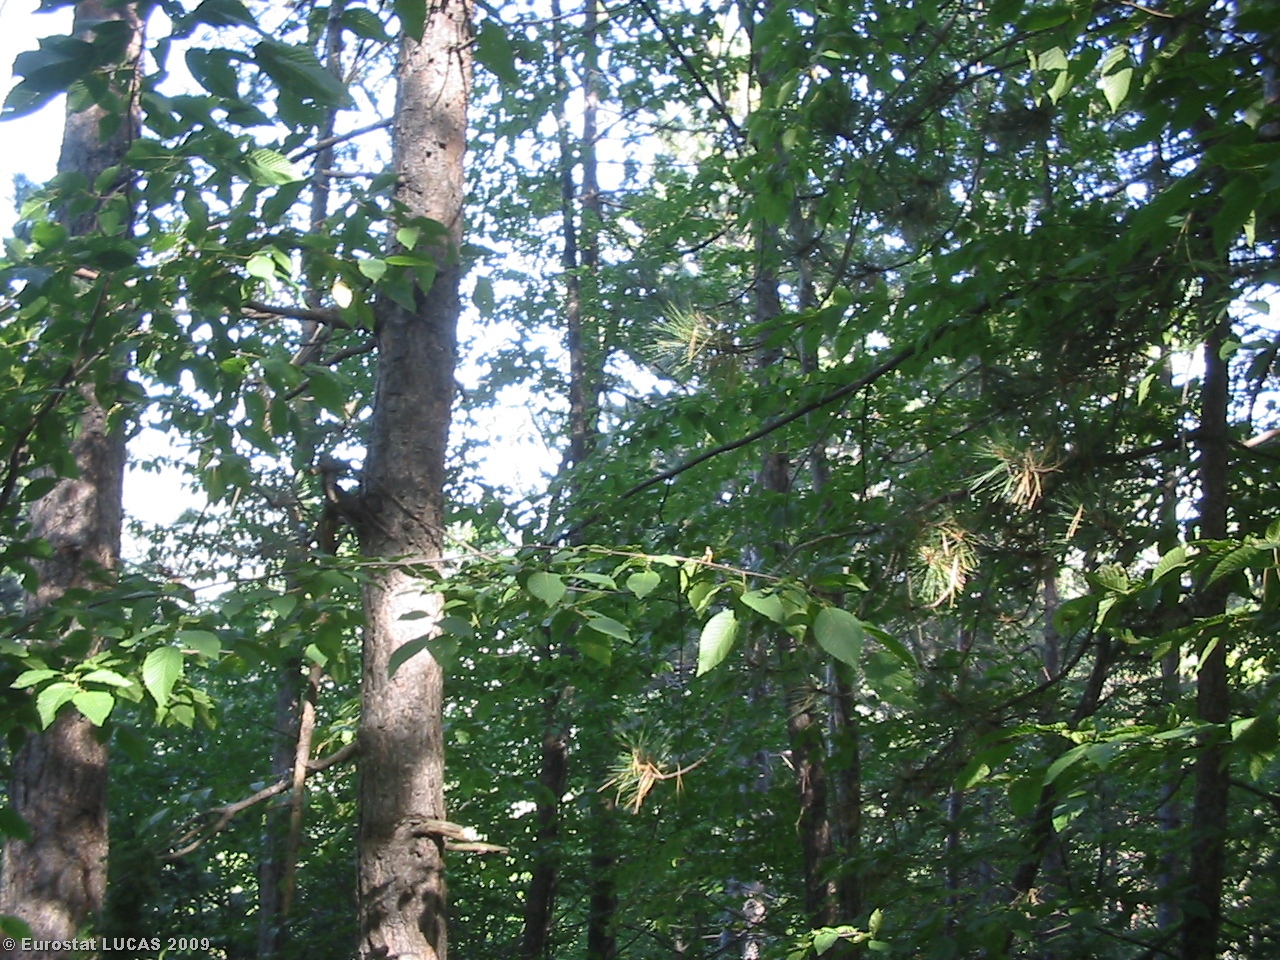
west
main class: Woodland
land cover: Mixed woodland
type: thermophilous deciduous forest
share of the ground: > 75 %
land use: Forestry
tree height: > 5 m
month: August
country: IT
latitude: 44.4044
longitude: 10.2380
